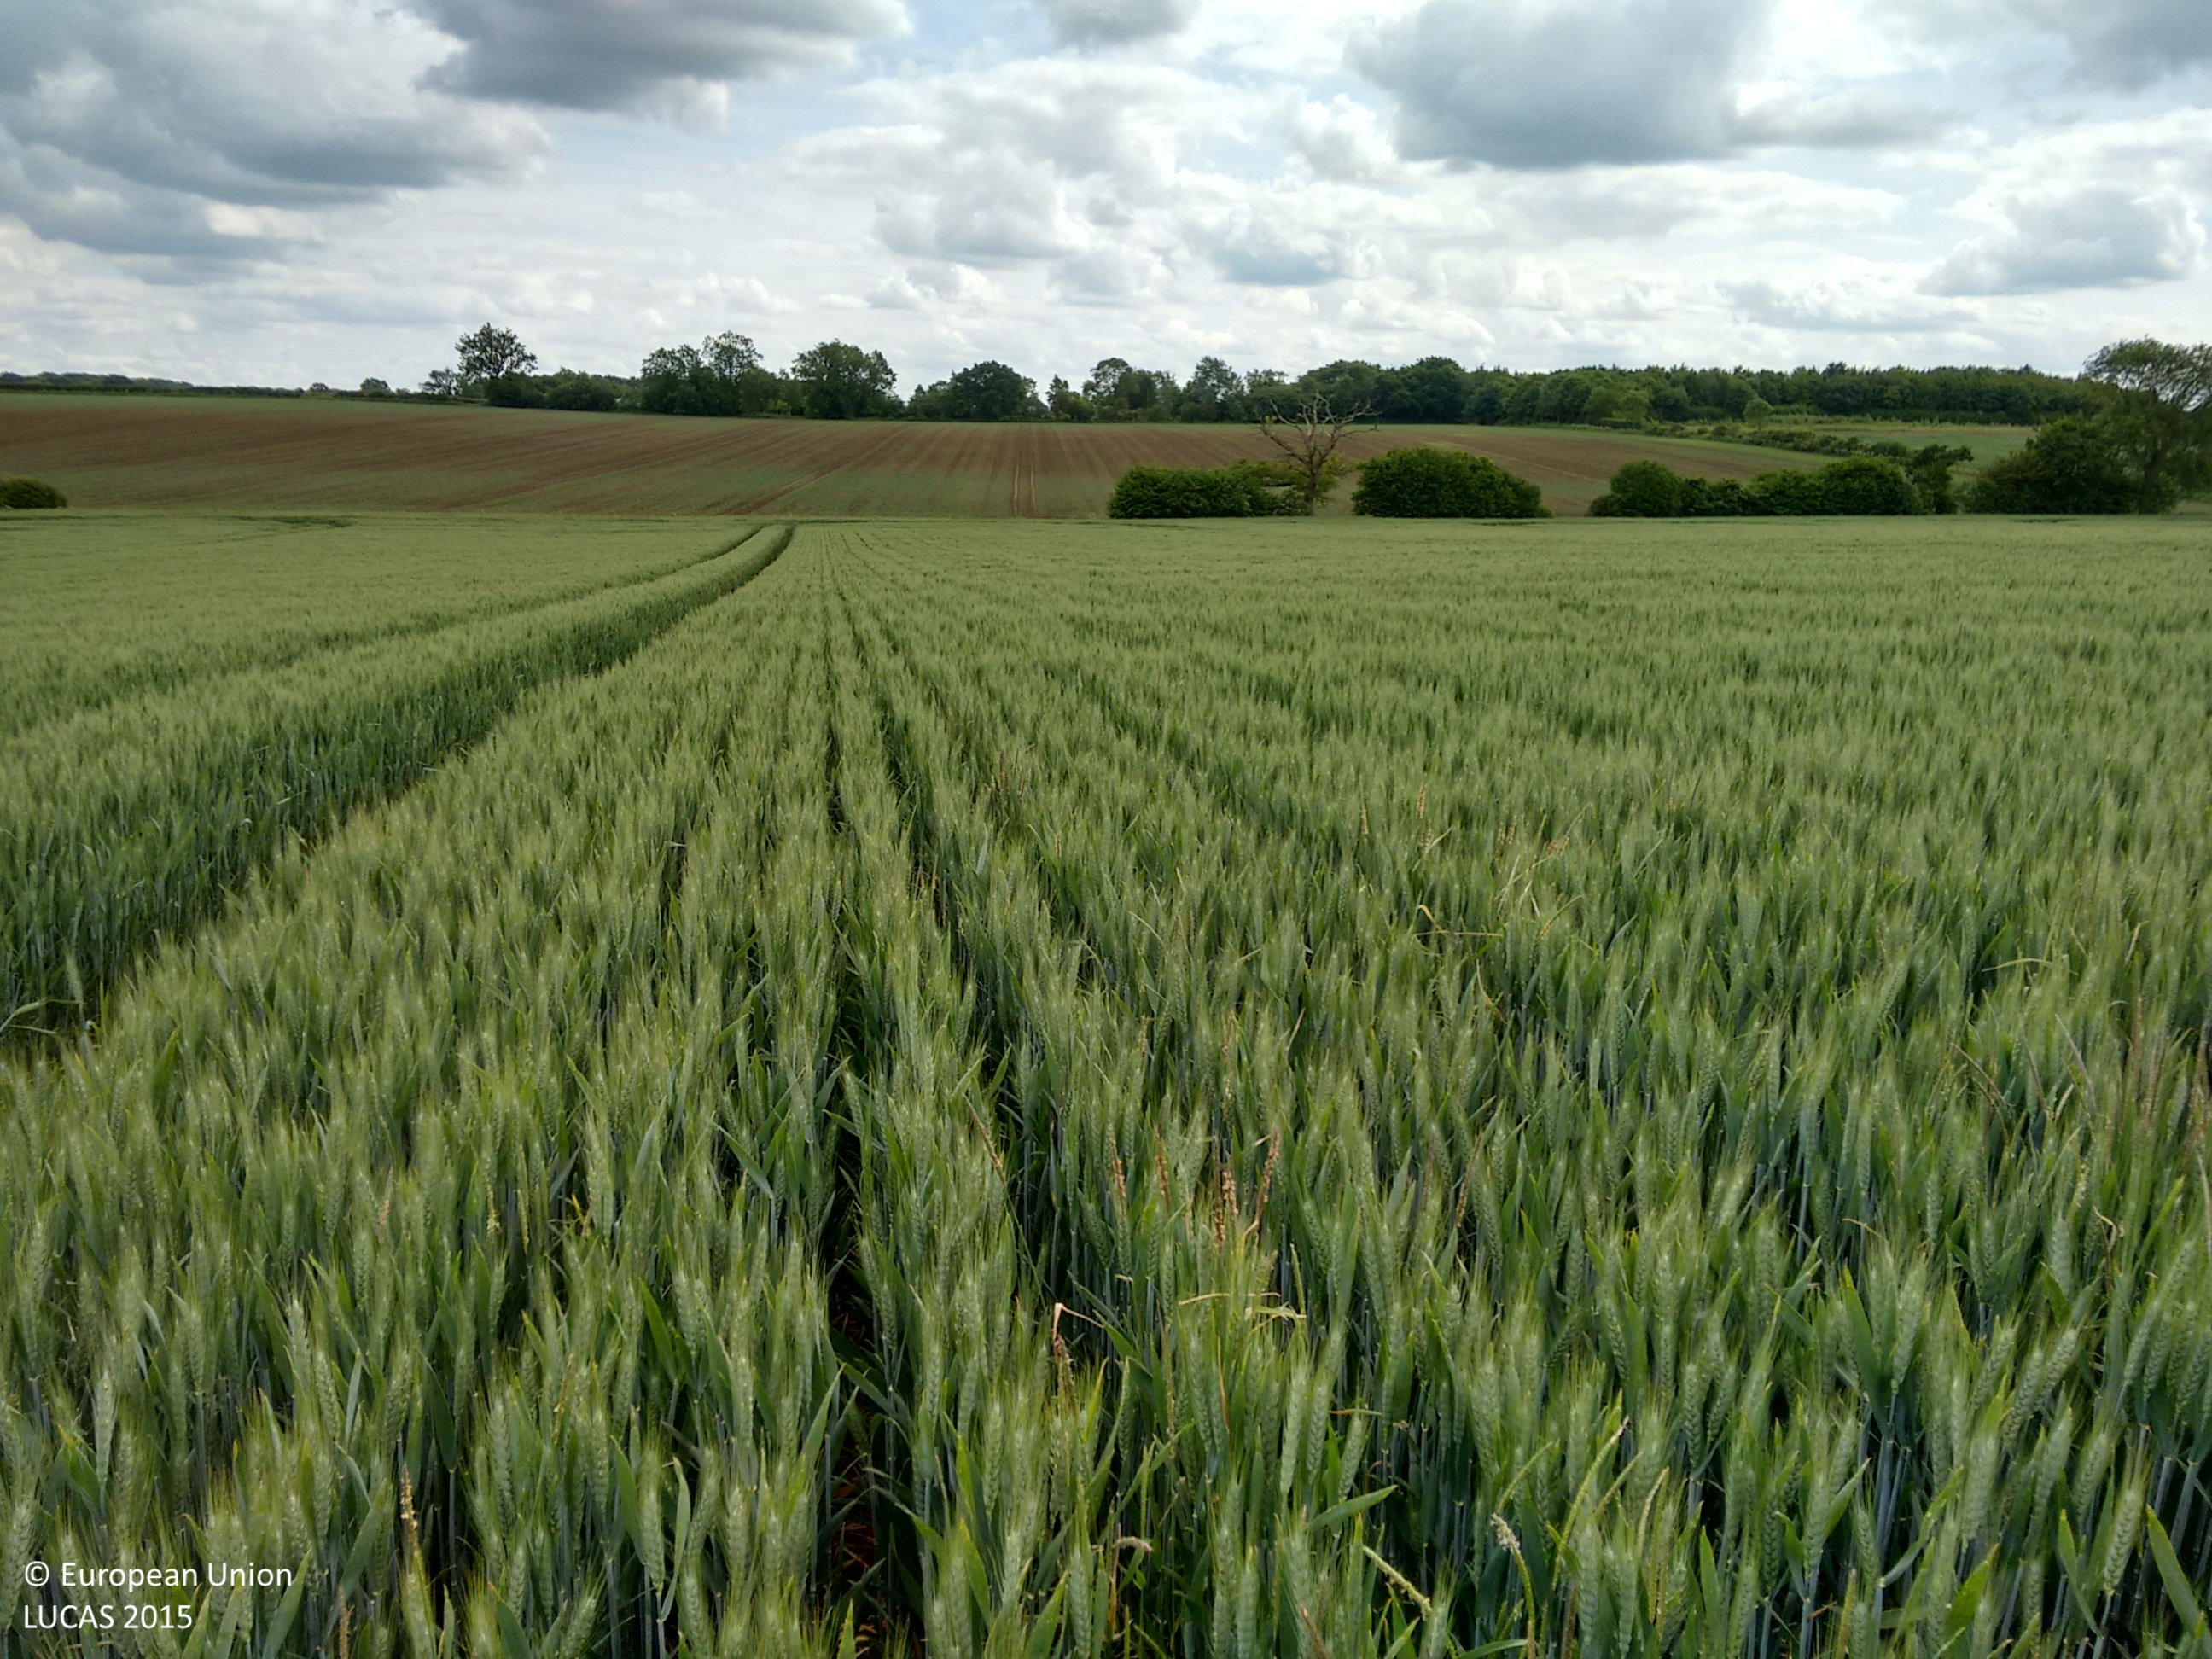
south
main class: Cropland
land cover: Common wheat
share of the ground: > 75 %
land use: Agriculture (excluding fallow land and kitchen gardens)
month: June
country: GB
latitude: 53.2031
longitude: -0.4417
